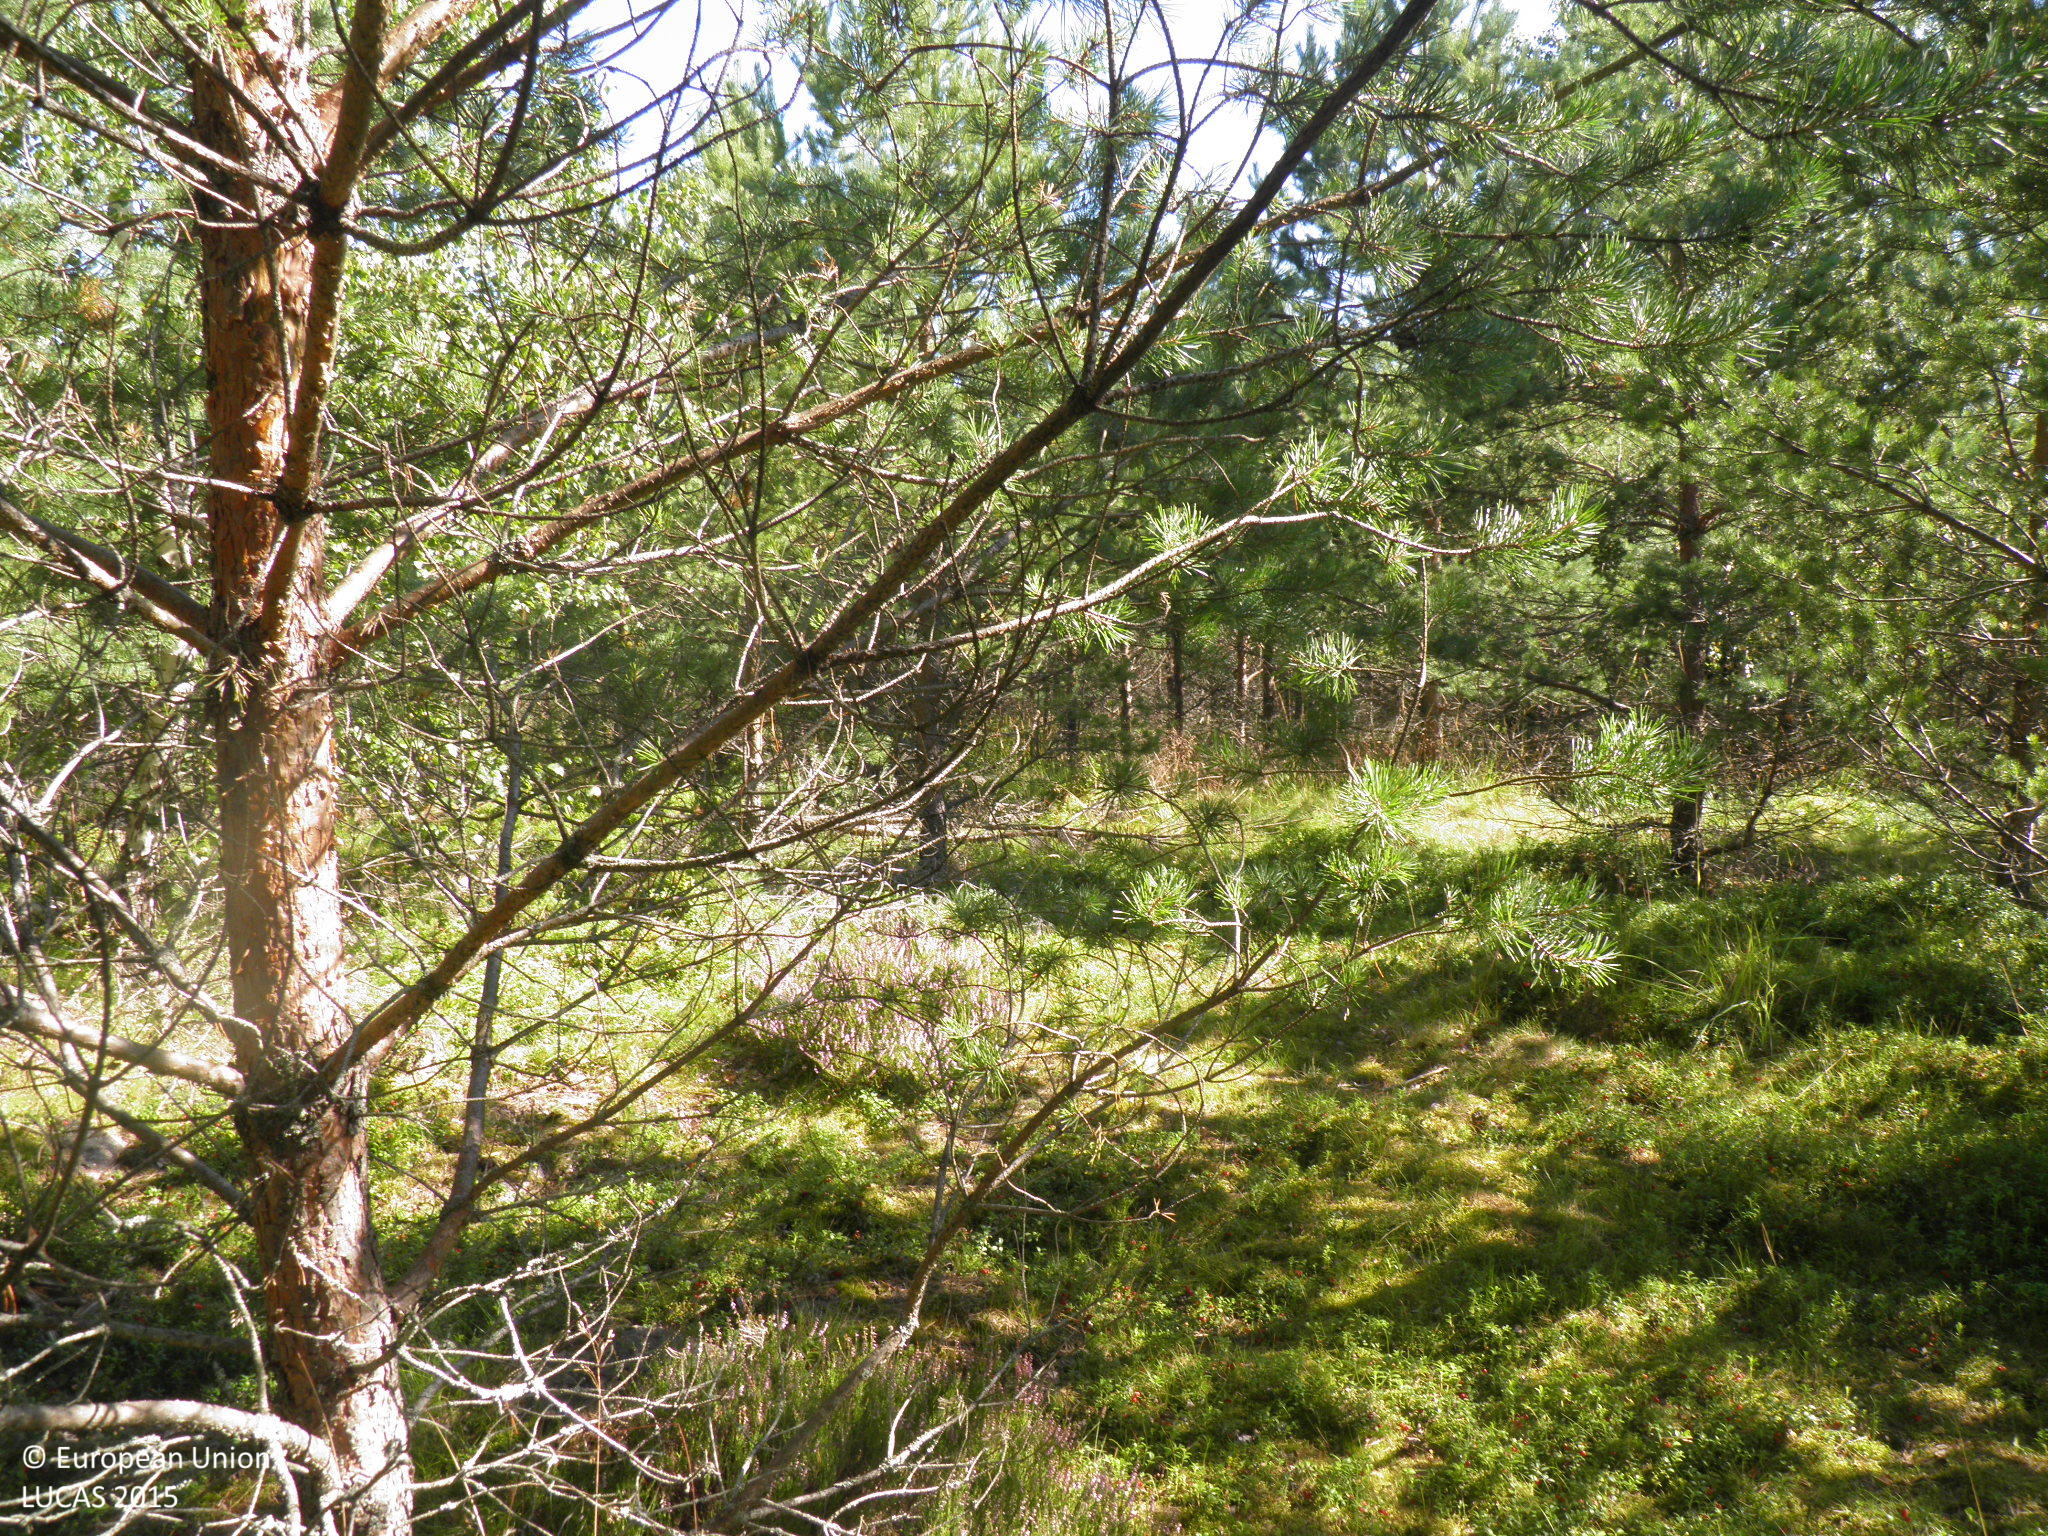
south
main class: Woodland
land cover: Pine dominated coniferous woodland
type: hemiboreal forest and nemoral coniferous forest and mixed broadleaved-coniferous forest
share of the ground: > 75 %
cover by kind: coniferous forest trees 80 %, shrubs 10 %, herbaceous plants 10 %
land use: Forestry
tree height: < 5 m
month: August
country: FI
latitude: 60.8107
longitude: 21.6183
